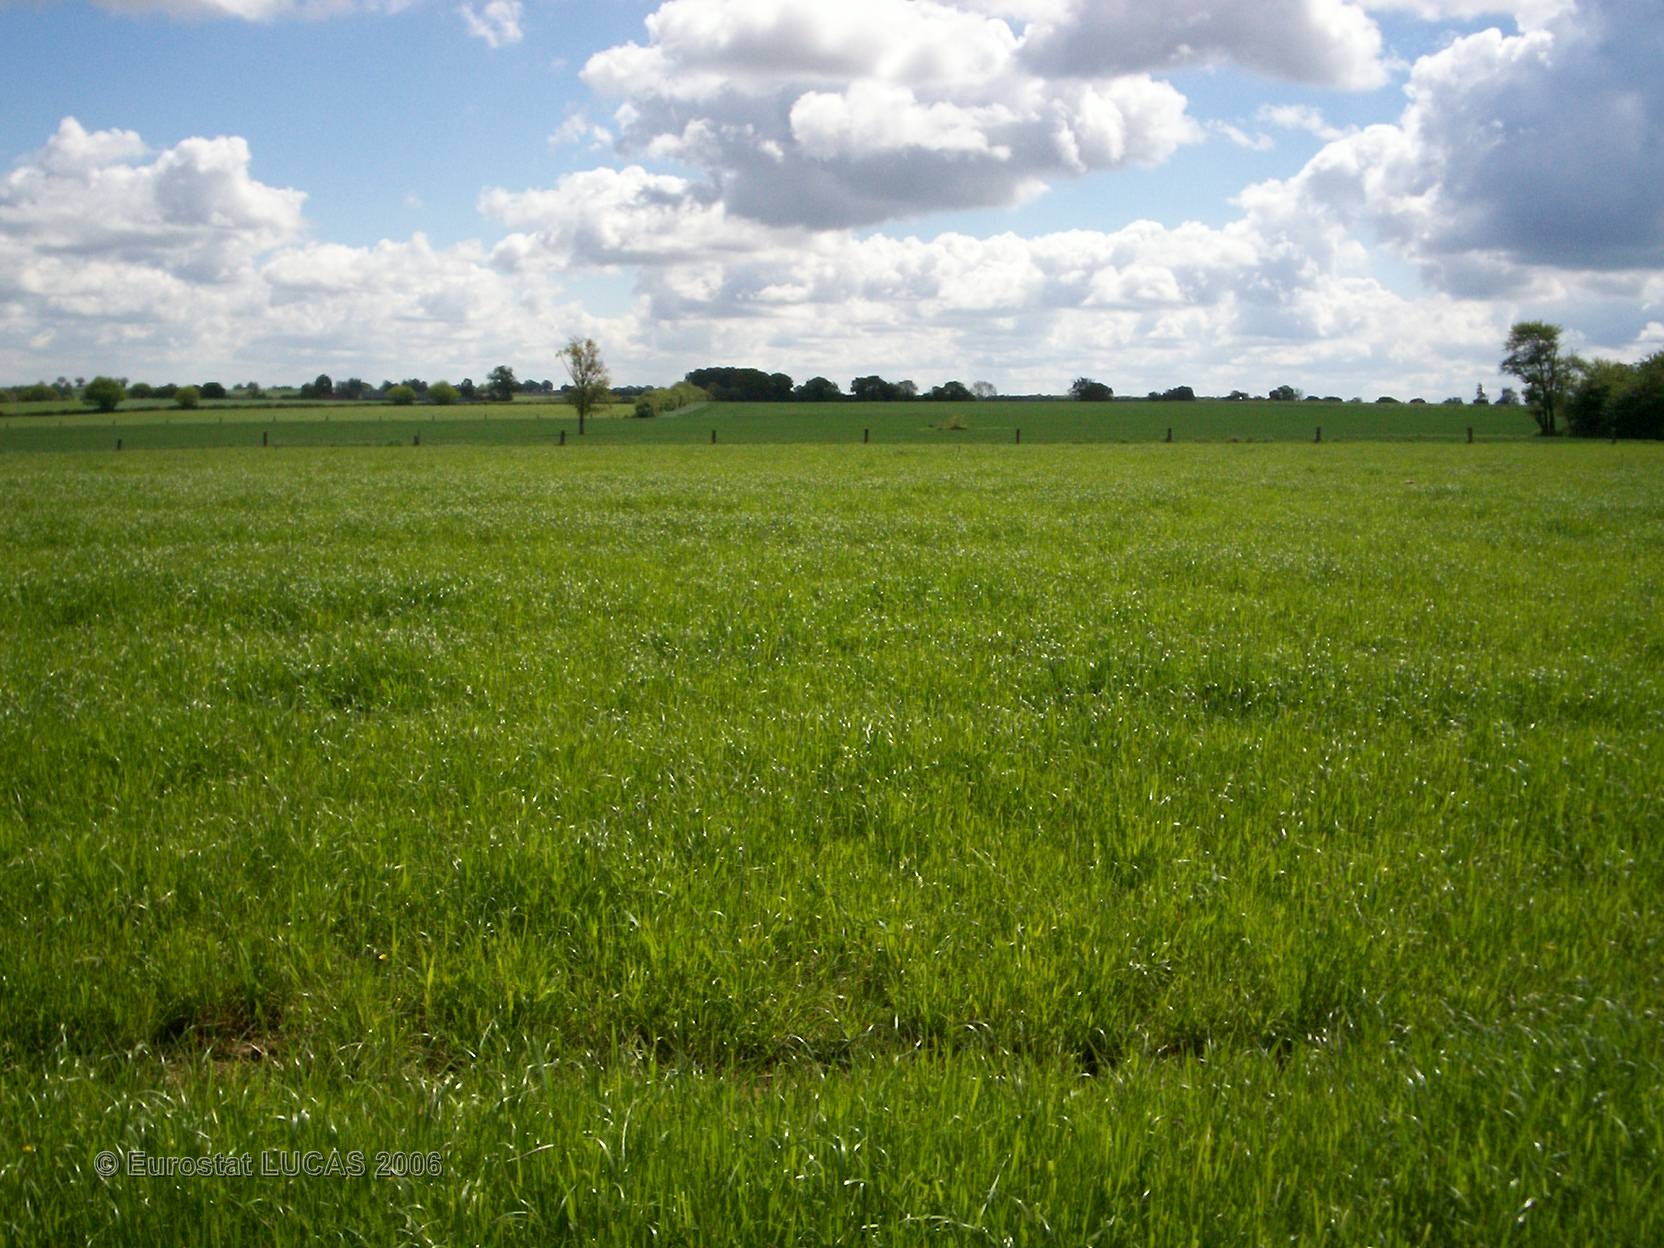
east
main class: Grassland
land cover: Grassland without tree/shrub cover
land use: Agriculture (excluding fallow land and kitchen gardens)
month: May
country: FR
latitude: 47.8971
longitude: -1.1016
